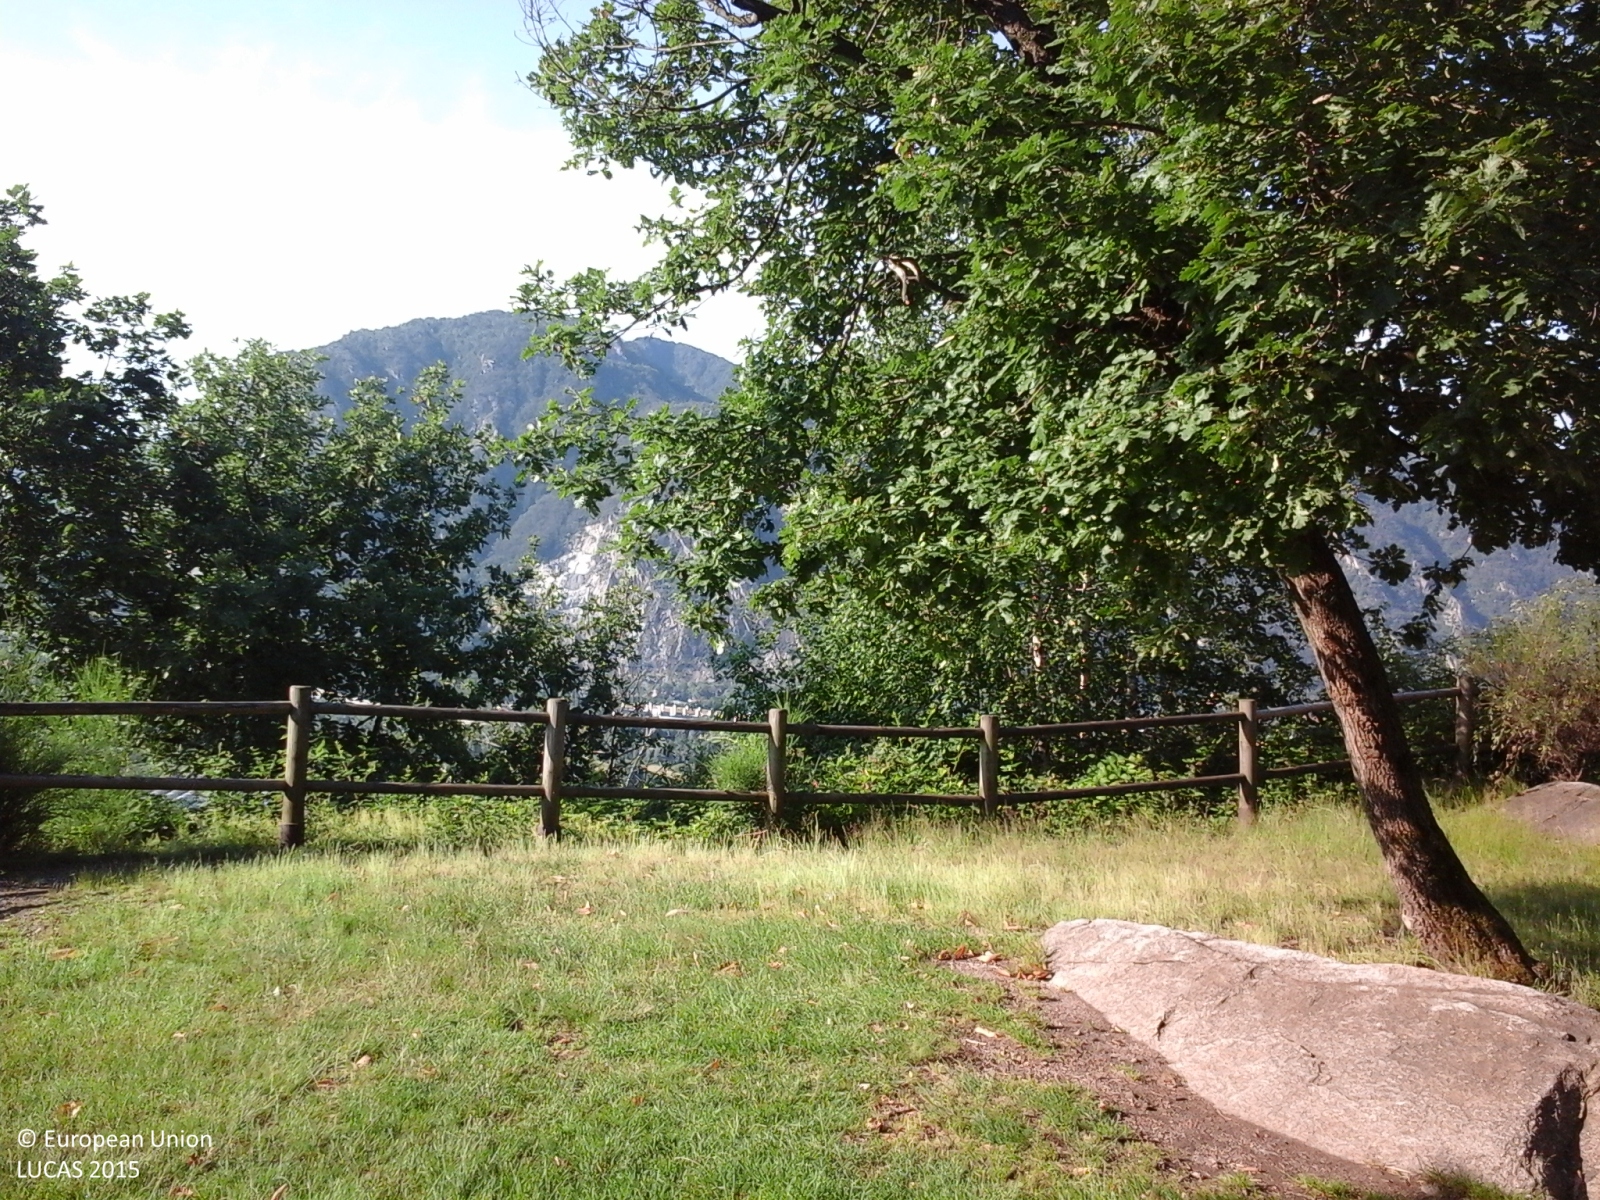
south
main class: Woodland
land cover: Broadleaved woodland
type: mesophytic deciduous forest
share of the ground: > 75 %
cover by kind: broadleaved forest trees 100 %
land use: Forestry
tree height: > 5 m
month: June
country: IT
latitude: 45.9438
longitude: 8.4672
